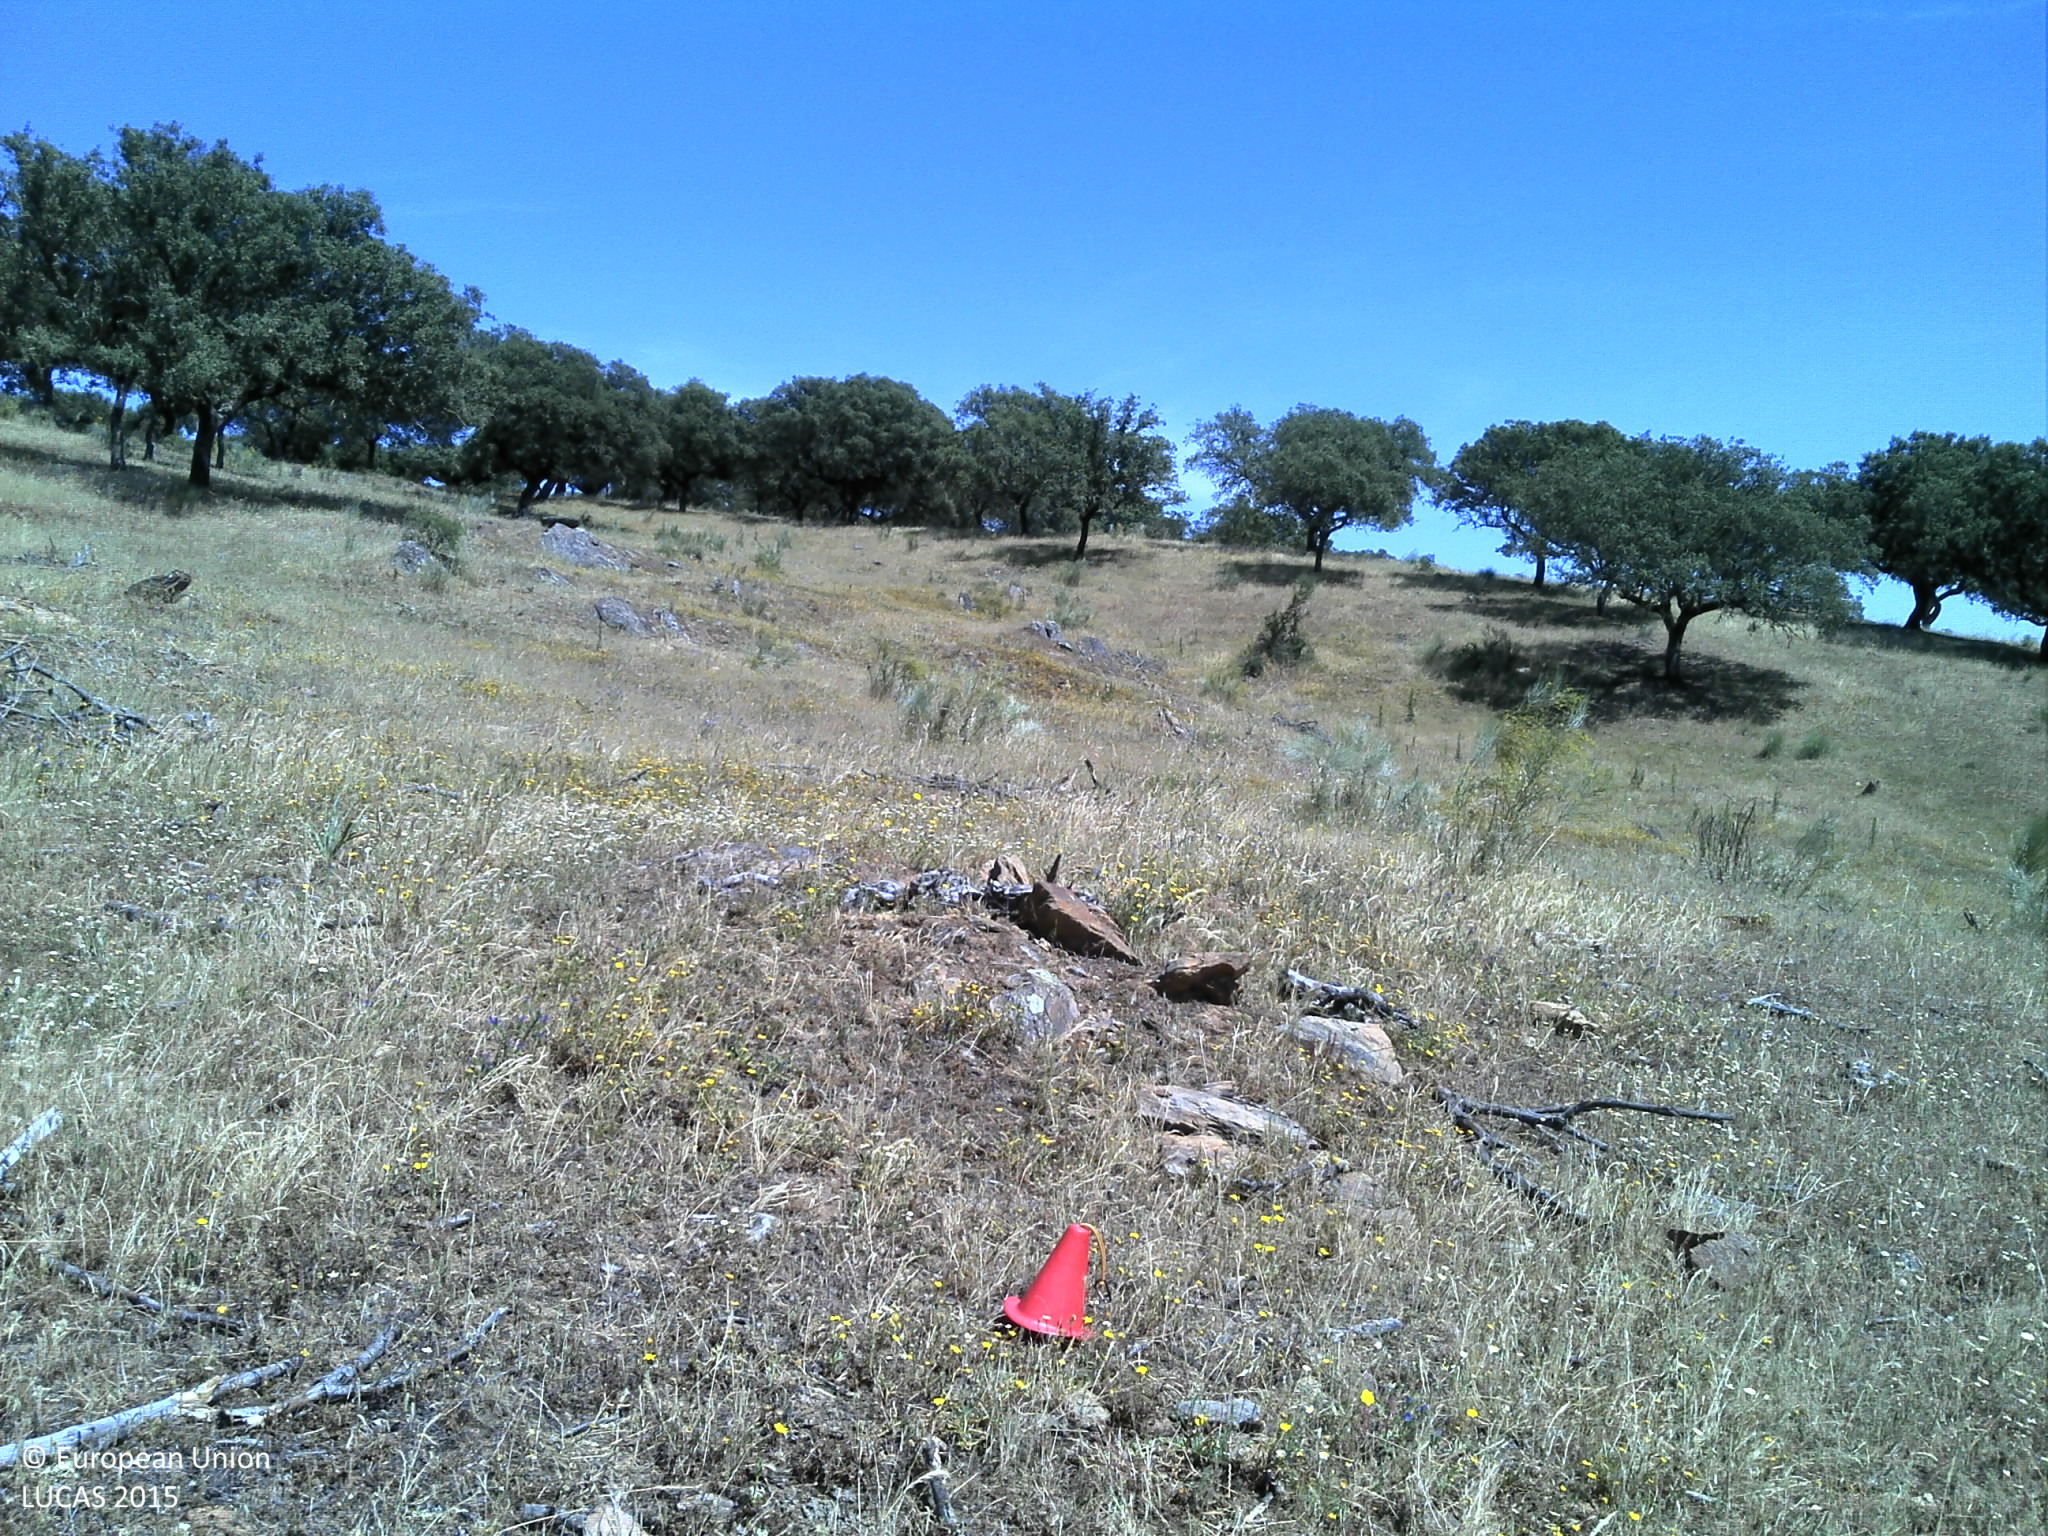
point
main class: Grassland
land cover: Grassland with sparse tree/shrub cover
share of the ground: 10 - 25 %
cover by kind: unconsolidated bare surface 70 %, herbaceous plants 25 %, broadleaved forest trees 5 %
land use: Agriculture (excluding fallow land and kitchen gardens)
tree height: > 5 m
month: May
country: PT
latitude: 39.2881
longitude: -7.6103
